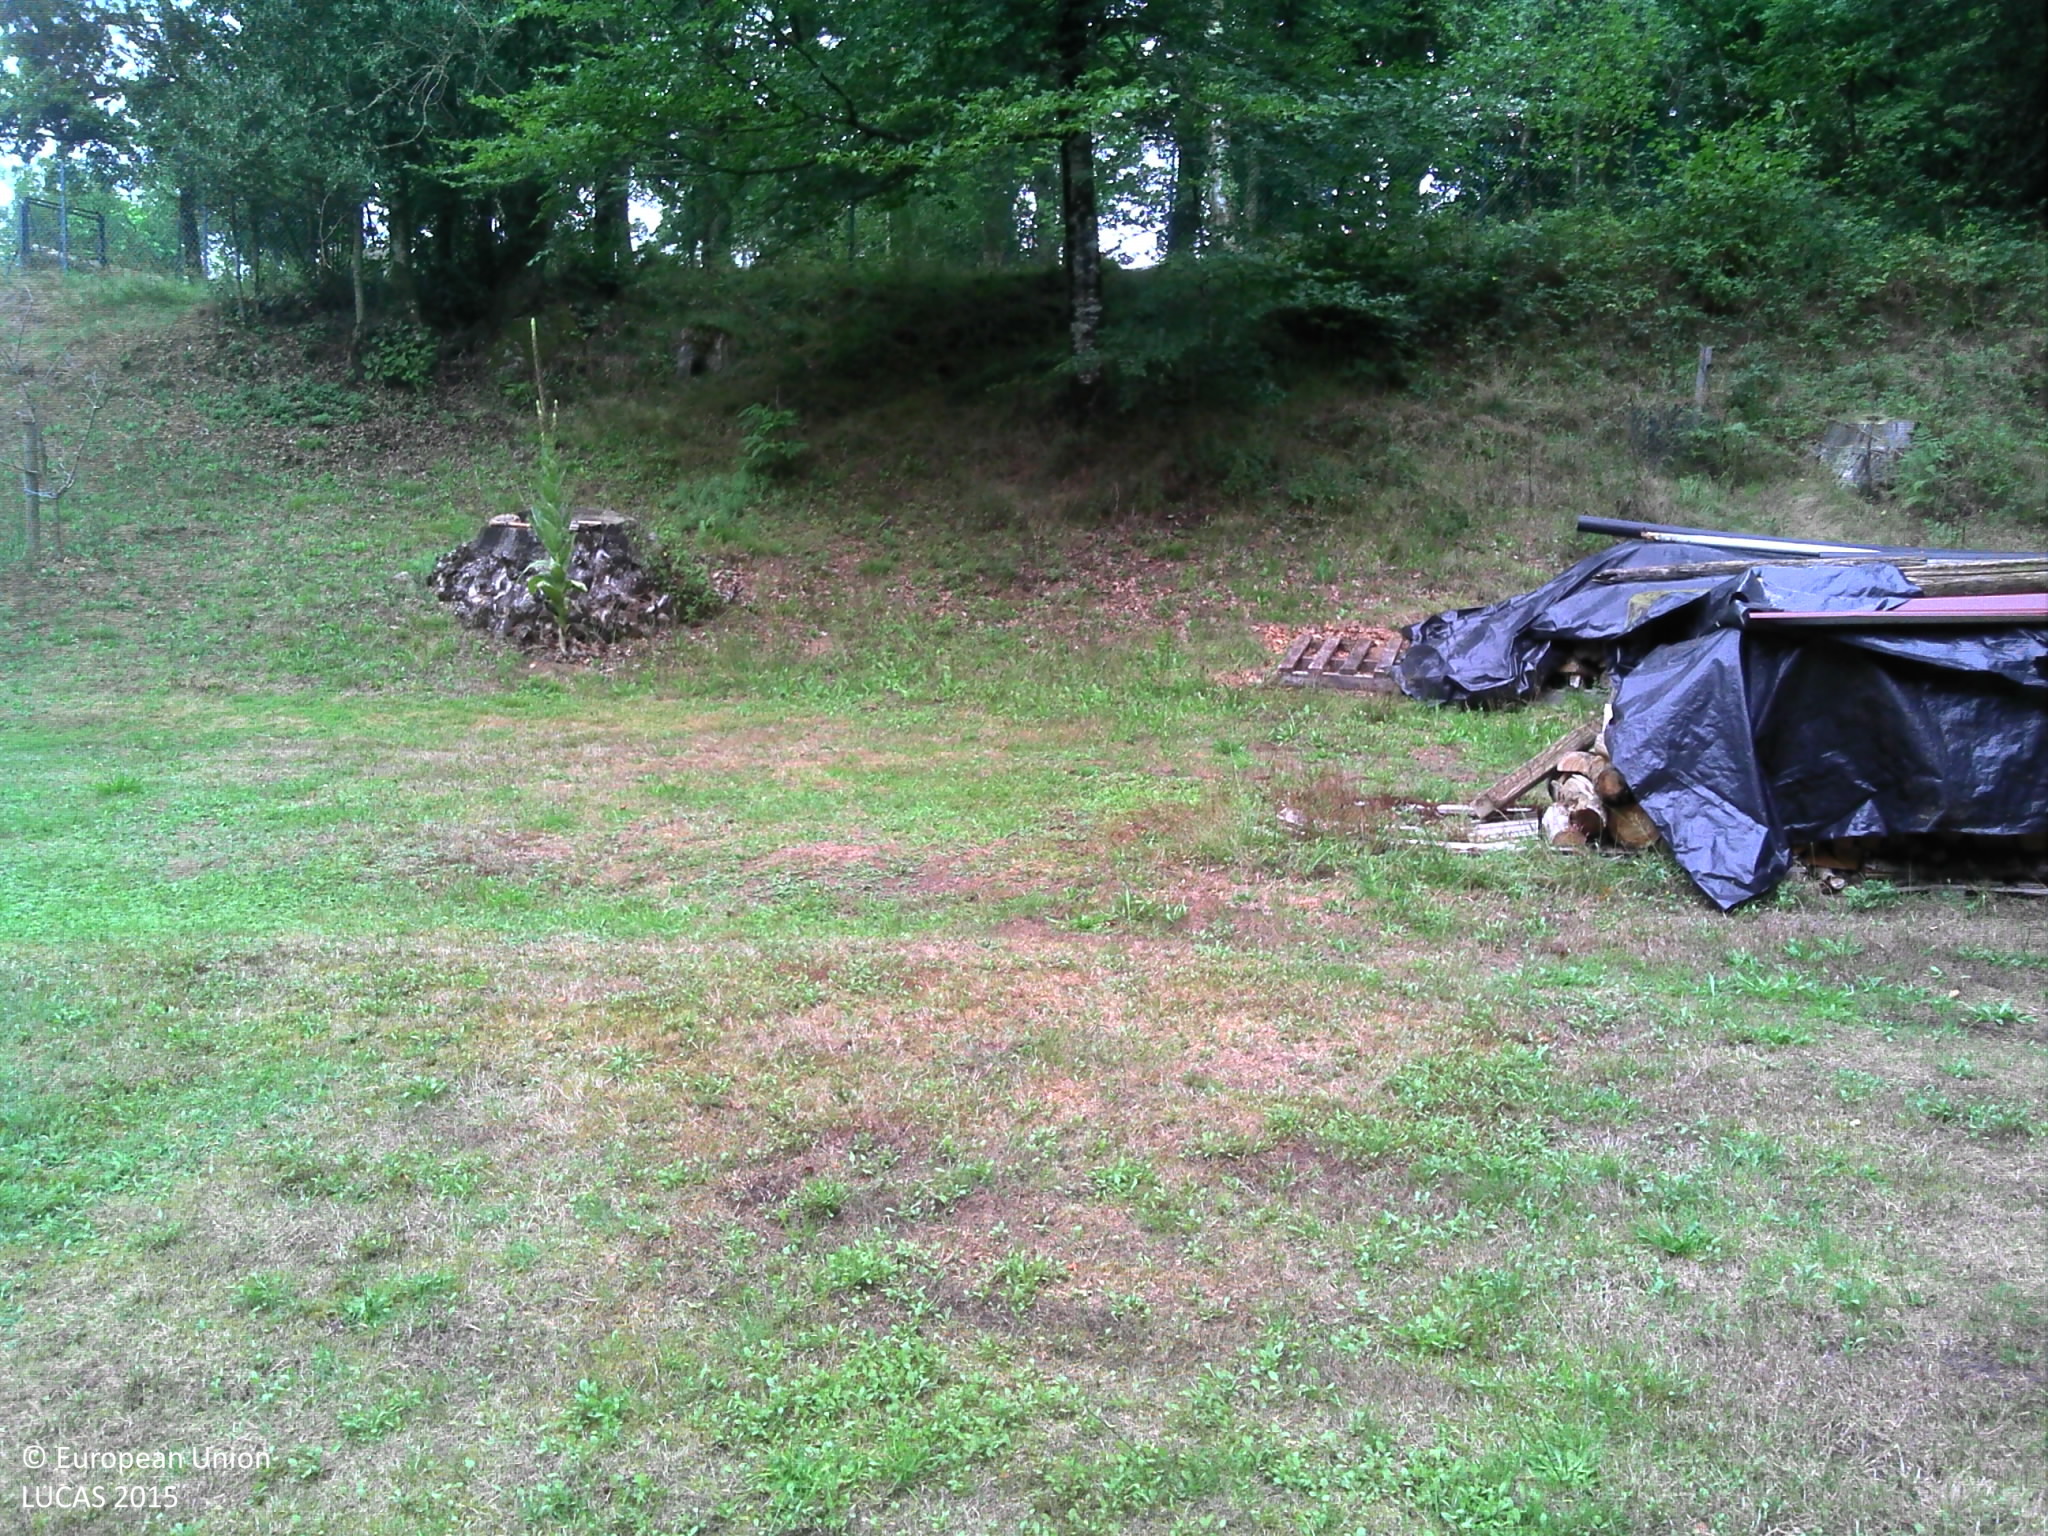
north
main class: Grassland
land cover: Grassland with sparse tree/shrub cover
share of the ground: > 75 %
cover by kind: herbaceous plants 95 %, broadleaved forest trees 5 %
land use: Sport
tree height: > 5 m
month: August
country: FR
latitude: 46.0141
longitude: 1.2980
